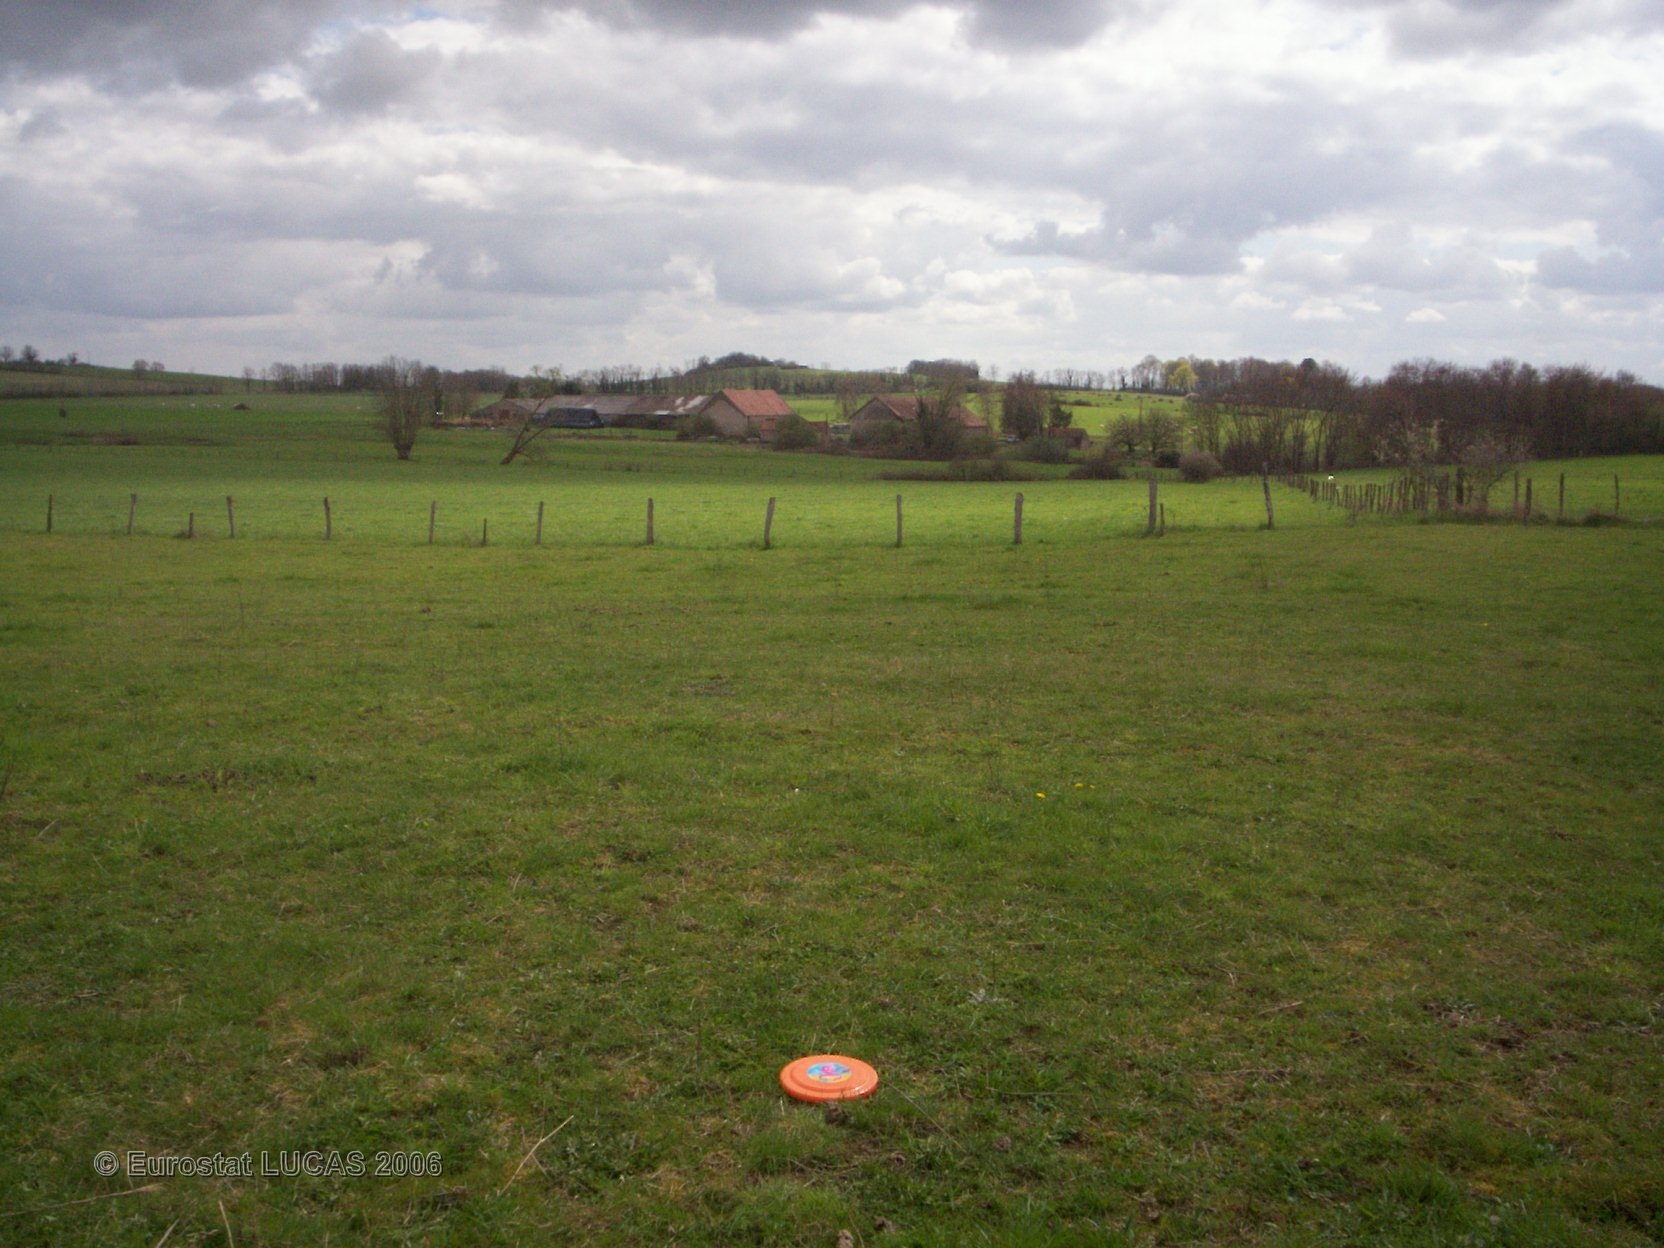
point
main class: Grassland
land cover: Grassland without tree/shrub cover
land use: Agriculture (excluding fallow land and kitchen gardens)
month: April
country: FR
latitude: 46.9219
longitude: 3.0756
